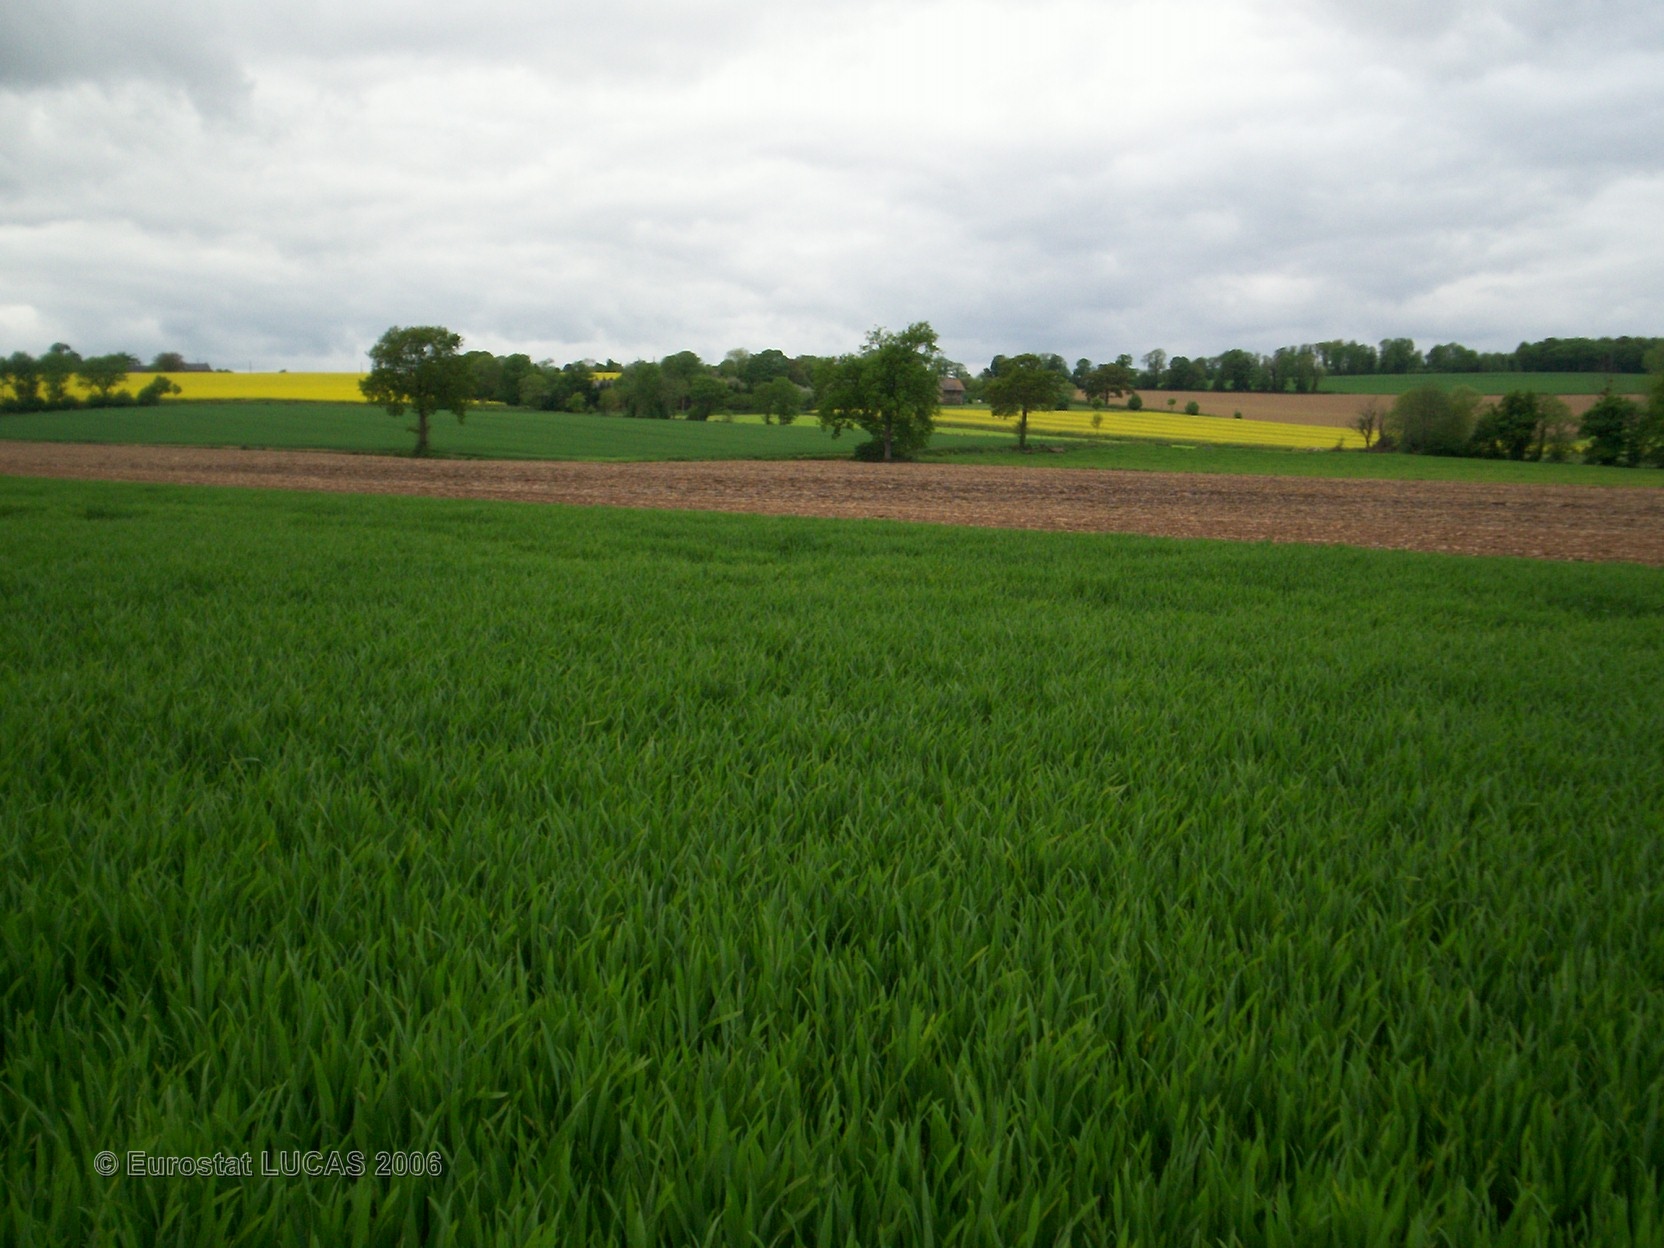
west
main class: Cropland
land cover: Common wheat
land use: Agriculture (excluding fallow land and kitchen gardens)
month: May
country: FR
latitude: 48.2878
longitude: -1.1882
